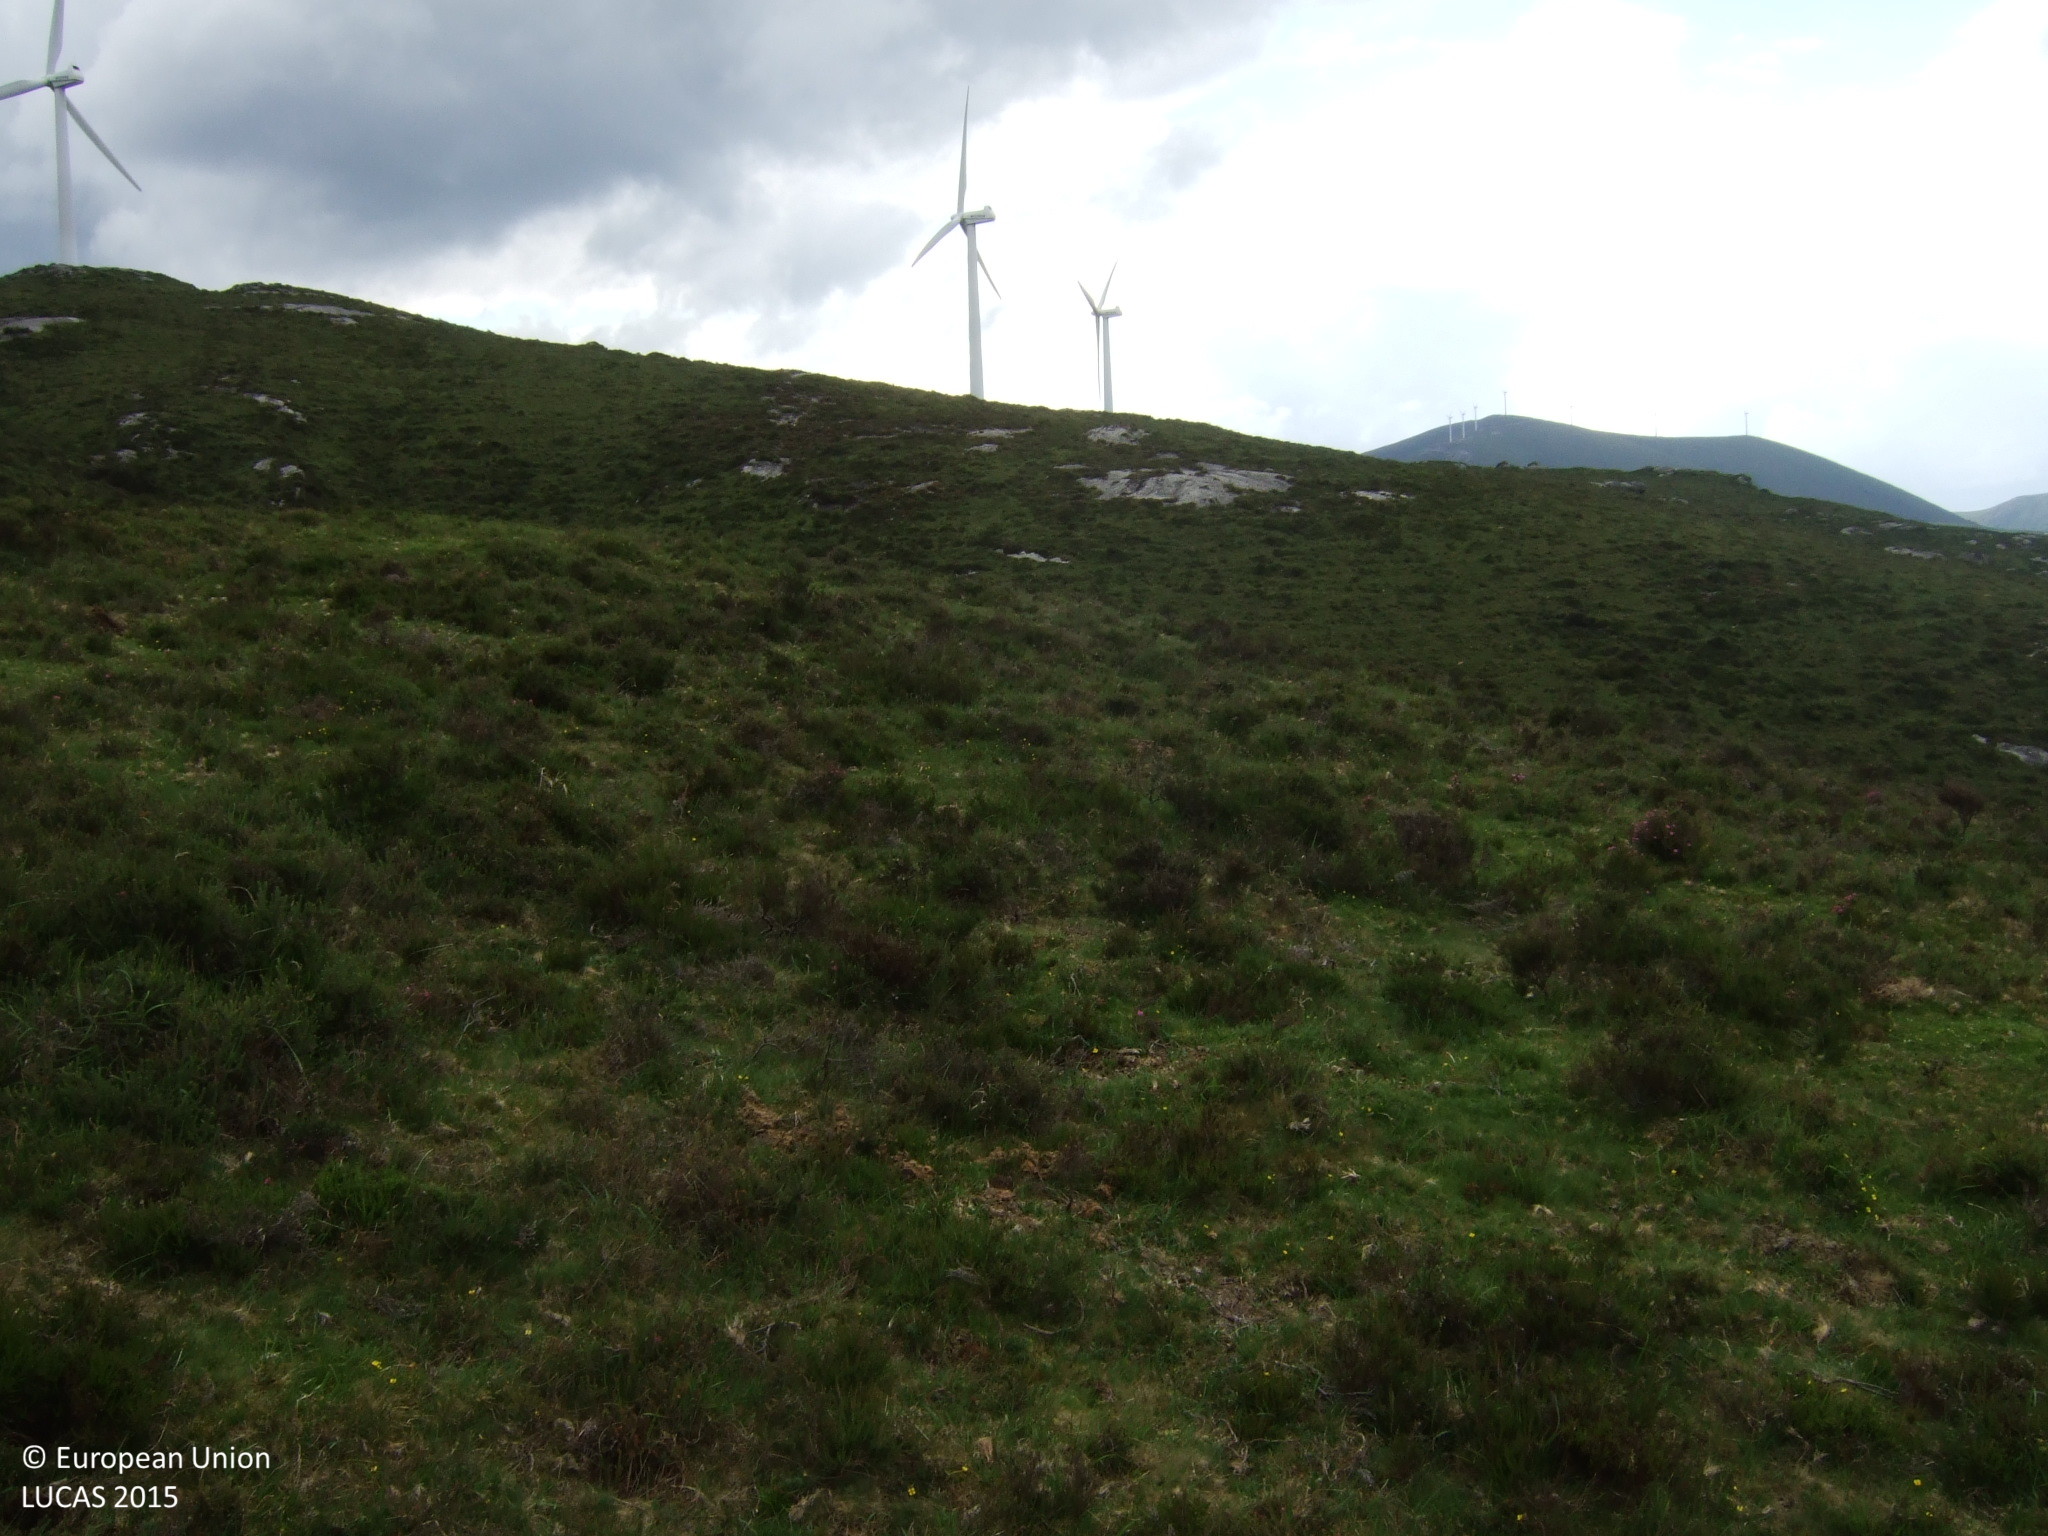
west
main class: Shrubland
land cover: Shrubland without tree cover
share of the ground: 25 - 50 %
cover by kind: herbaceous plants 60 %, shrubs 40 %
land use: Agriculture (excluding fallow land and kitchen gardens)
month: June
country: ES
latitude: 43.4581
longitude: -7.4947
